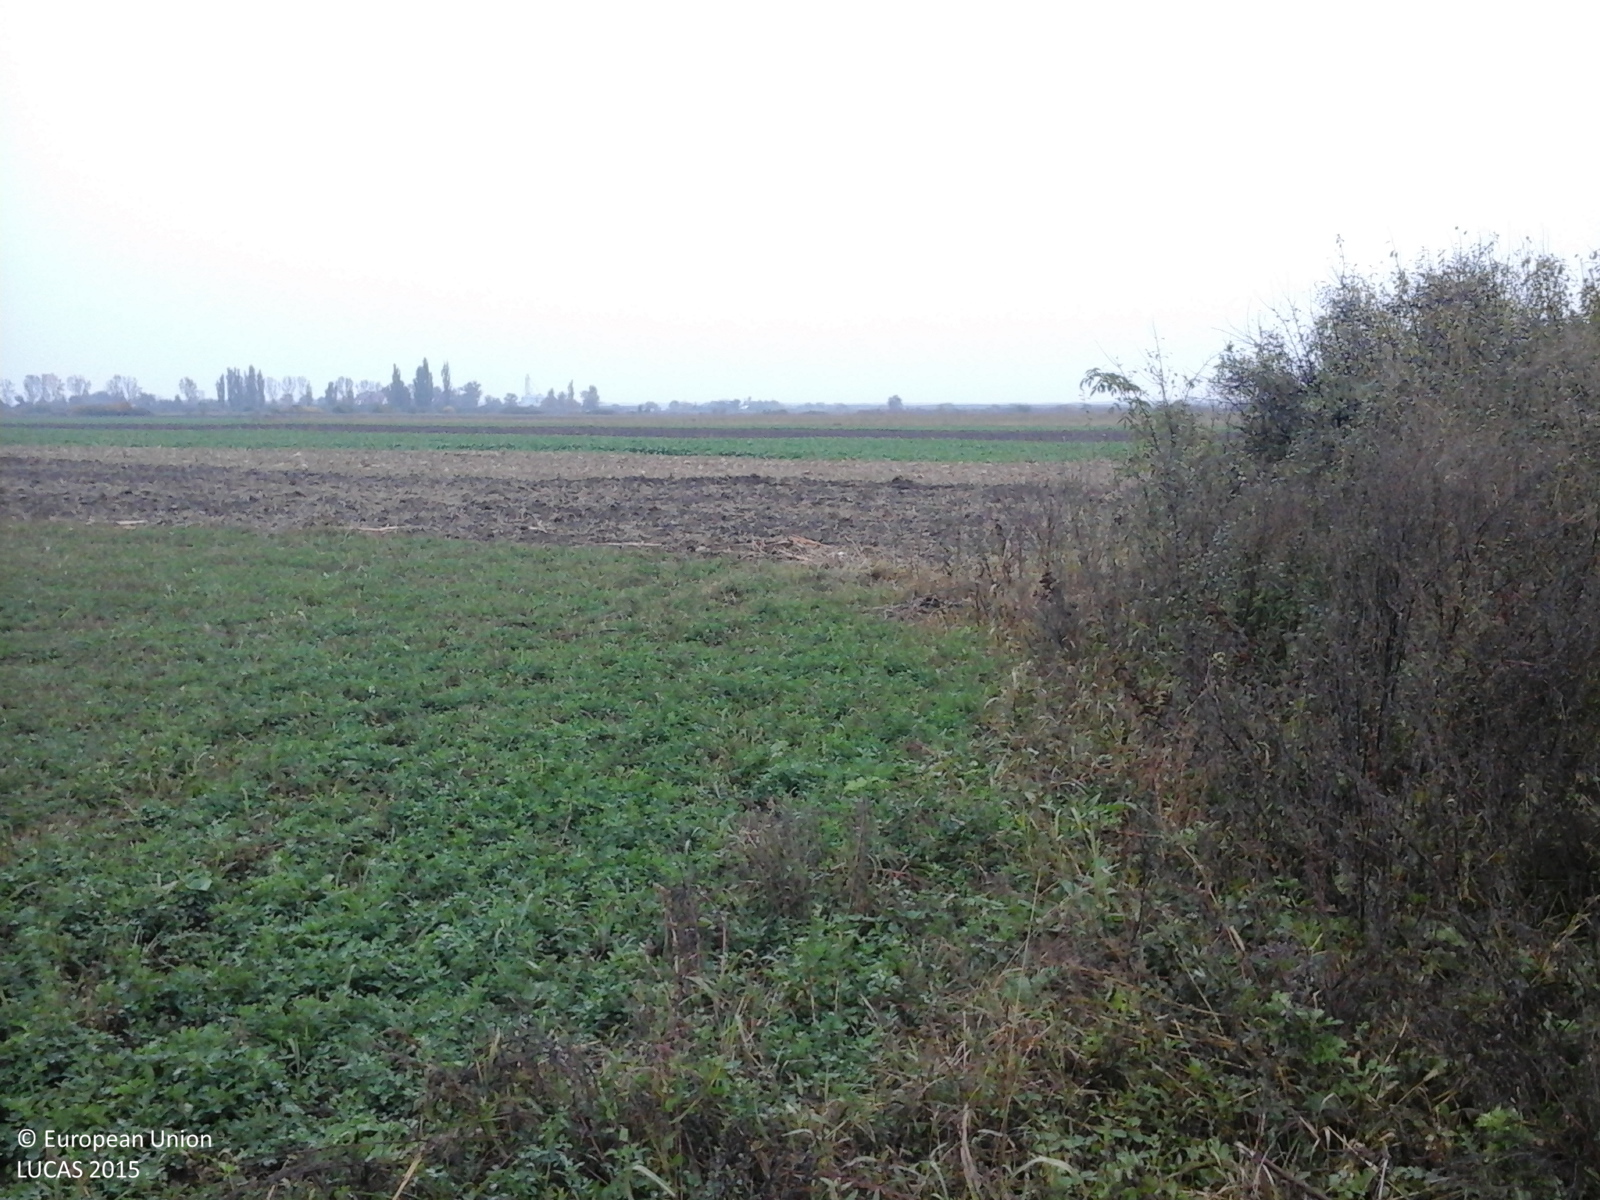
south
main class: Cropland
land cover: Maize
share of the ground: > 75 %
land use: Agriculture (excluding fallow land and kitchen gardens)
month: October
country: RO
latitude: 44.8418
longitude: 26.0094
